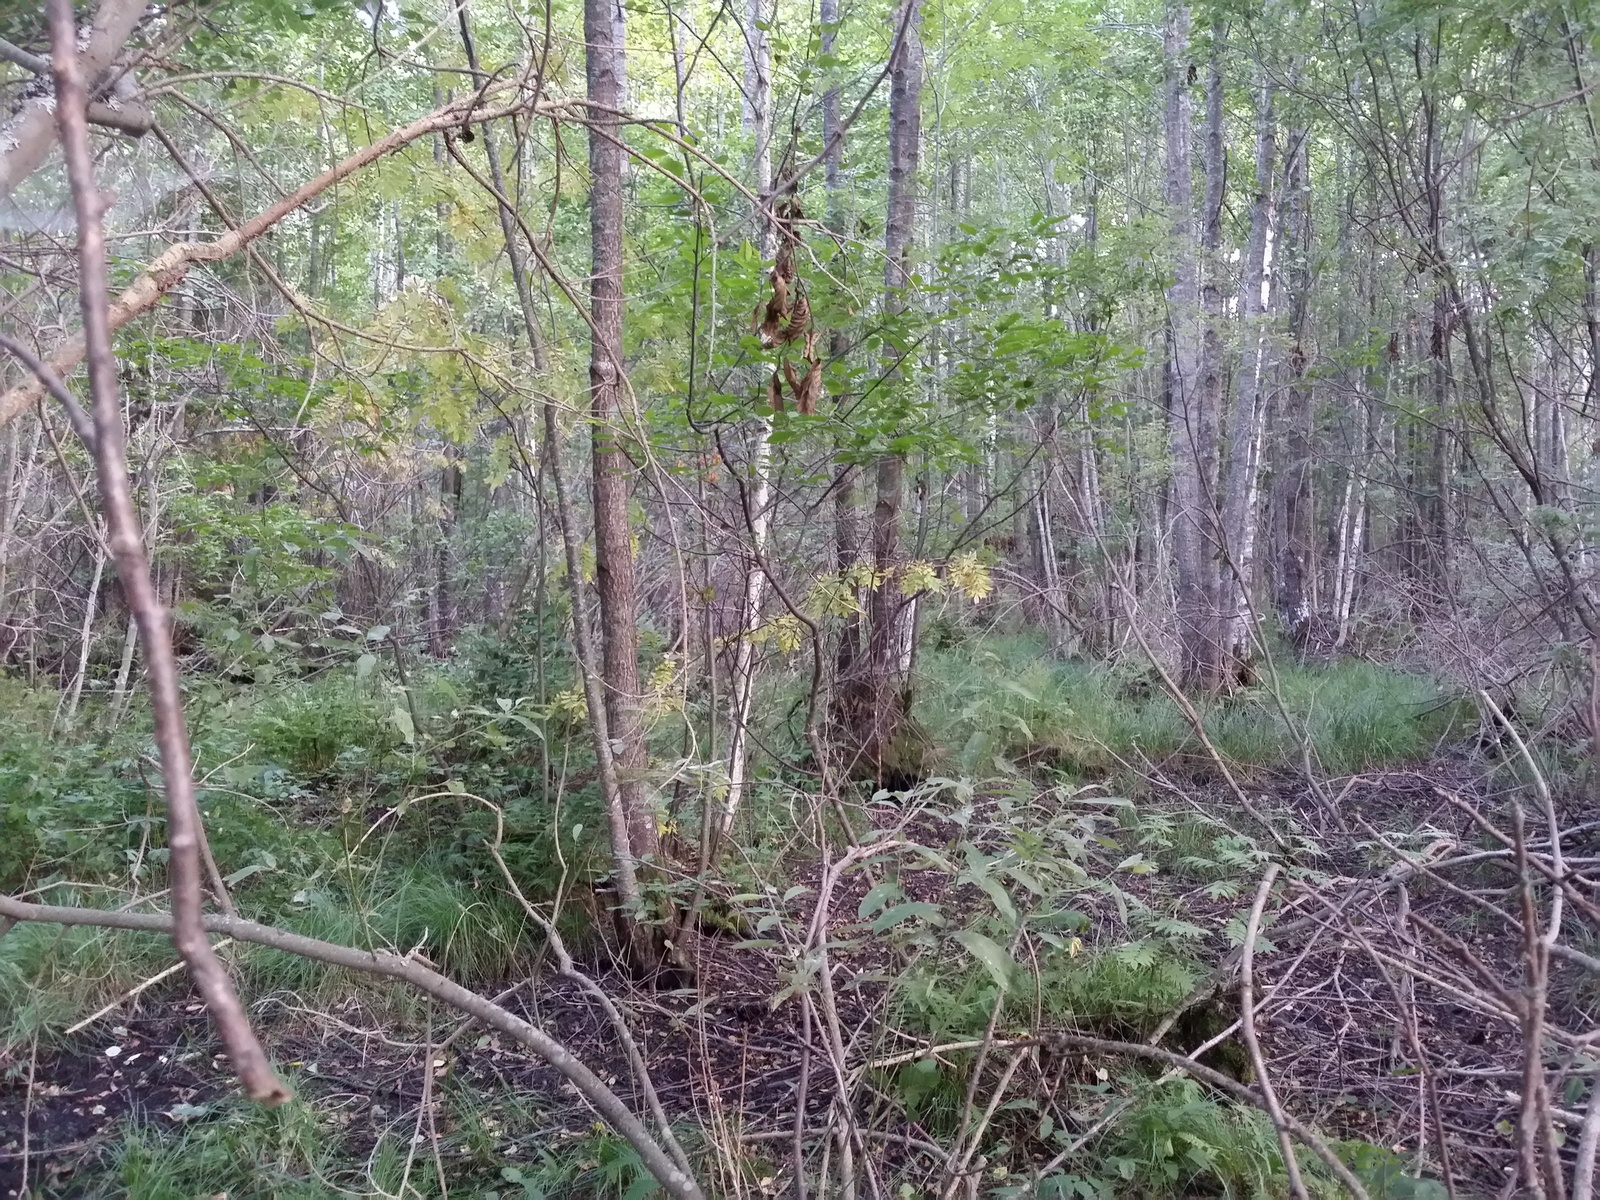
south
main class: Woodland
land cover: Broadleaved woodland
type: non-riverine alder, birch or aspen forest
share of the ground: > 75 %
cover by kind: broadleaved forest trees 85 %, herbaceous plants 10 %, unconsolidated bare surface 5 %
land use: Forestry
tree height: > 5 m
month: August
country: LV
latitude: 57.2337
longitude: 27.6930
